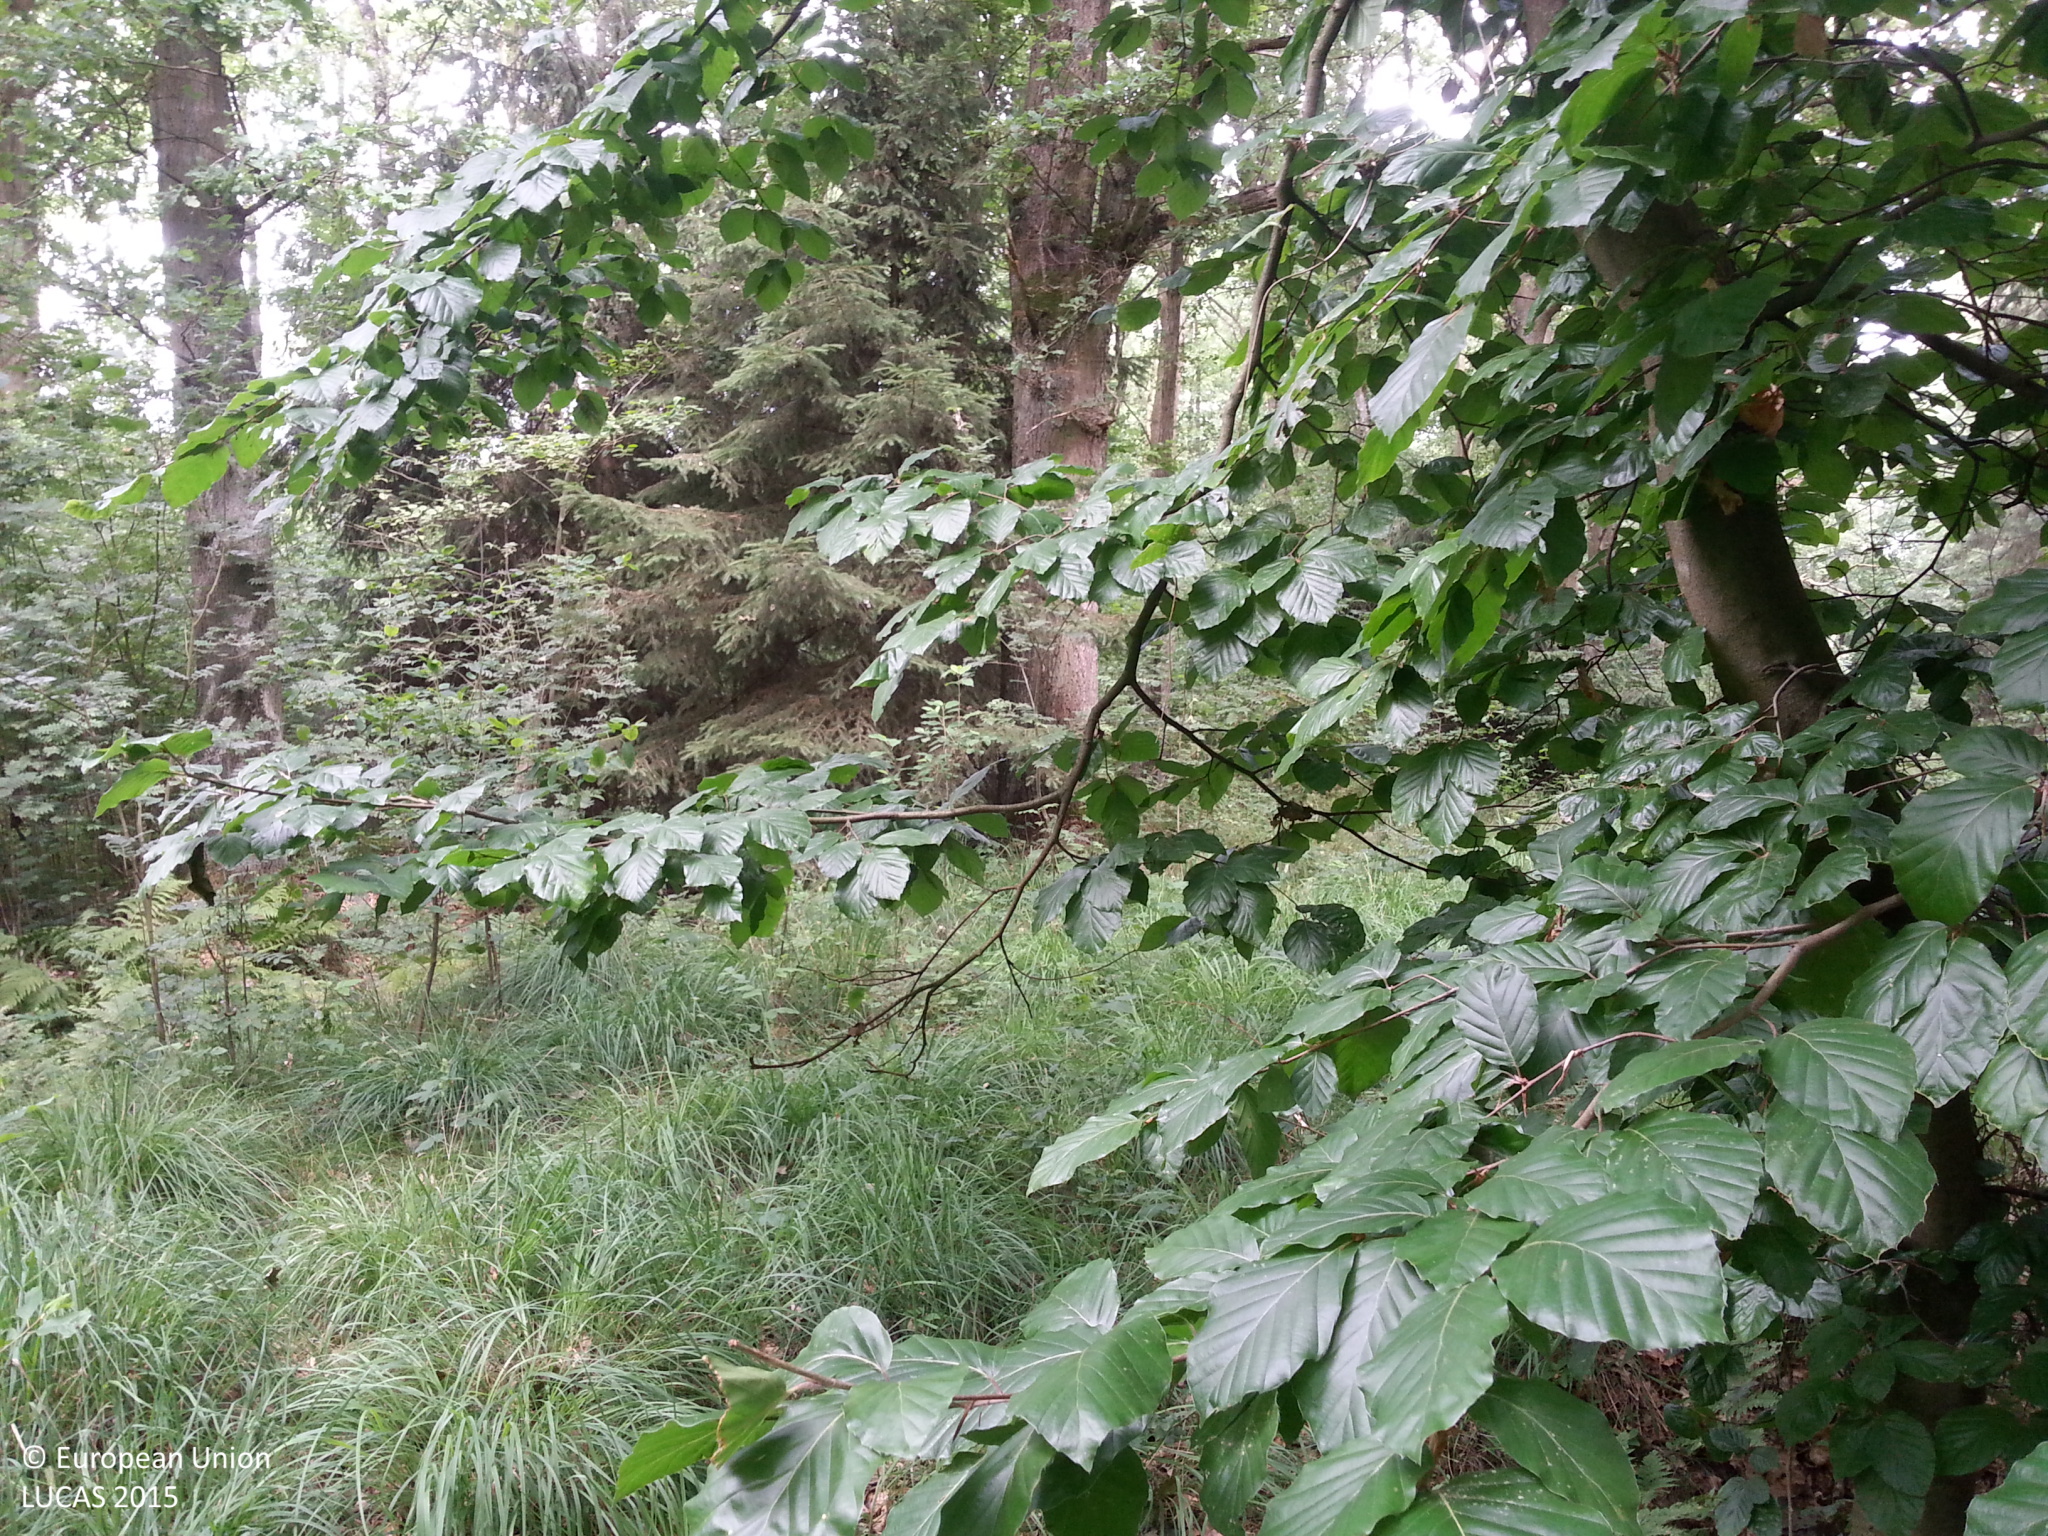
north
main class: Woodland
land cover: Pine dominated mixed woodland
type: hemiboreal forest and nemoral coniferous forest and mixed broadleaved-coniferous forest
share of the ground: 50 - 75 %
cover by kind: coniferous forest trees 45 %, broadleaved forest trees 25 %, shrubs 20 %, herbaceous plants 5 %, unconsolidated bare surface 5 %
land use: Forestry
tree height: > 5 m
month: July
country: DE
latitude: 53.5401
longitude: 11.1614
